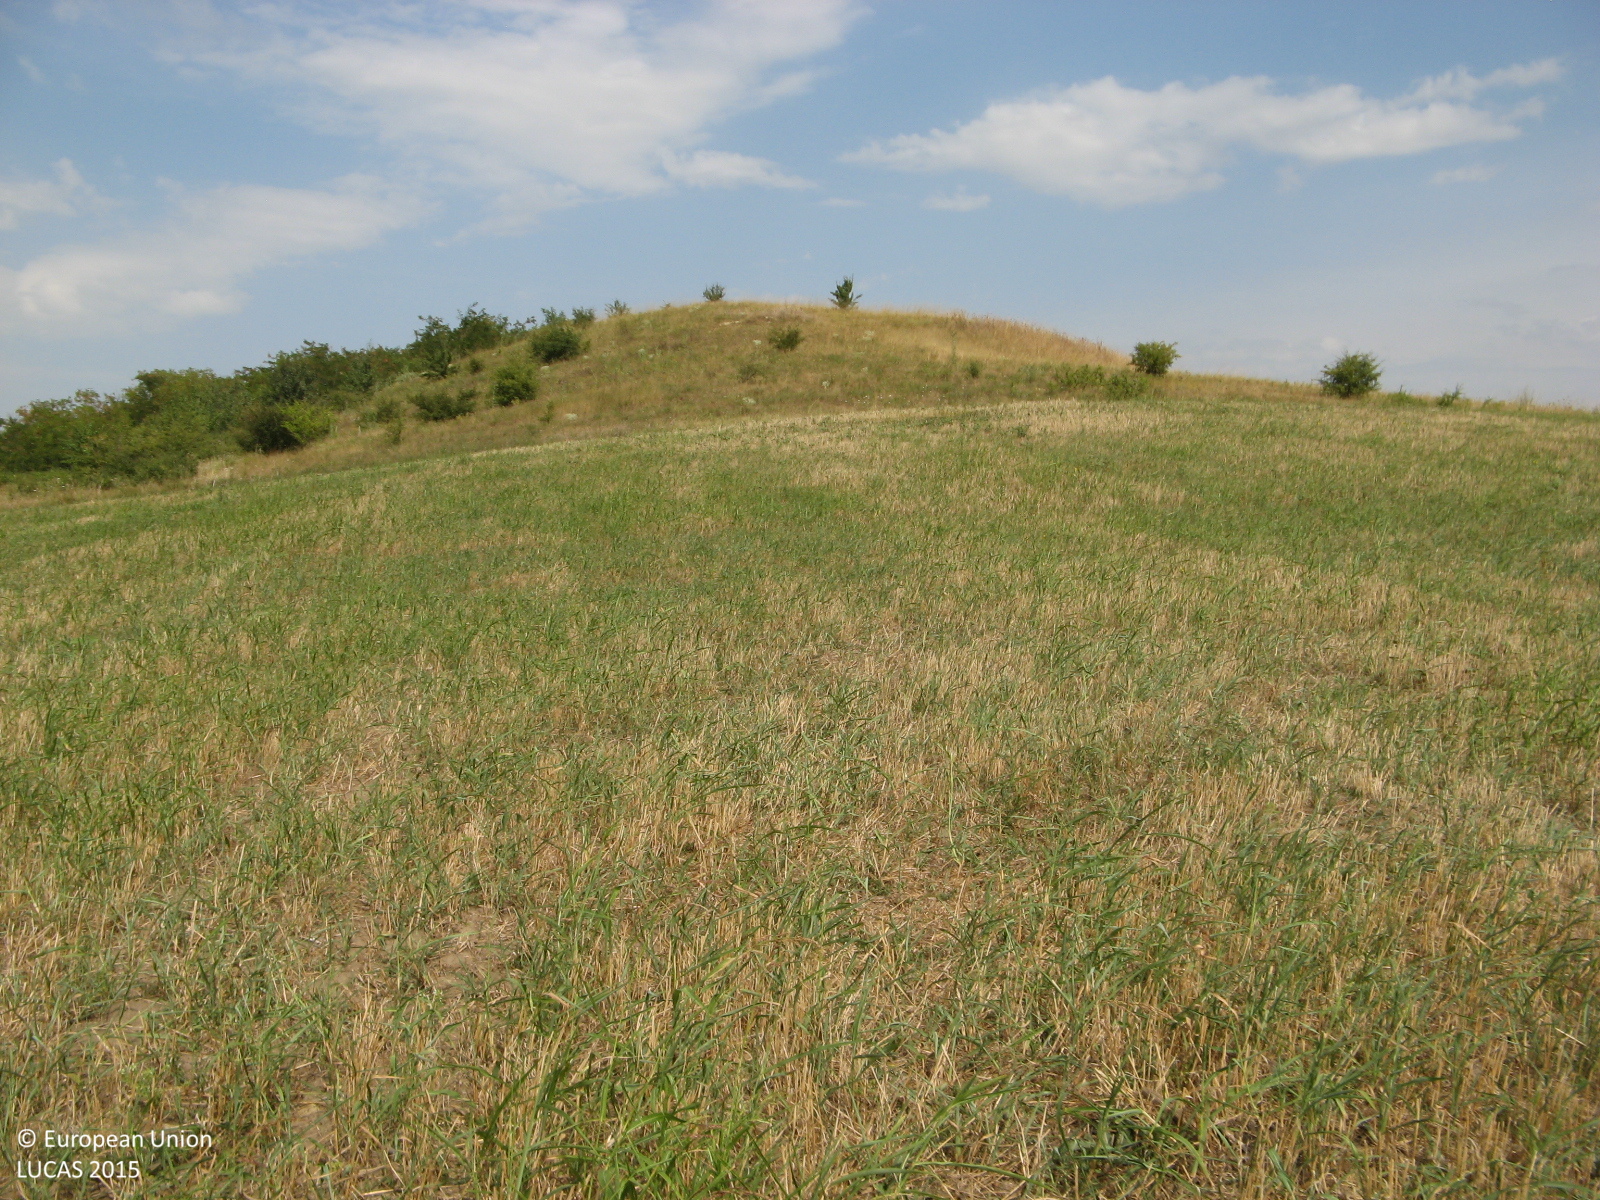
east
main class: Cropland
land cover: Common wheat
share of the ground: 50 - 75 %
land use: Agriculture (excluding fallow land and kitchen gardens)
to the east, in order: Common wheat; Grassland with sparse tree/shrub cover; Other bare soil; Common wheat
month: August
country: BG
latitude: 43.4694
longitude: 25.2683
